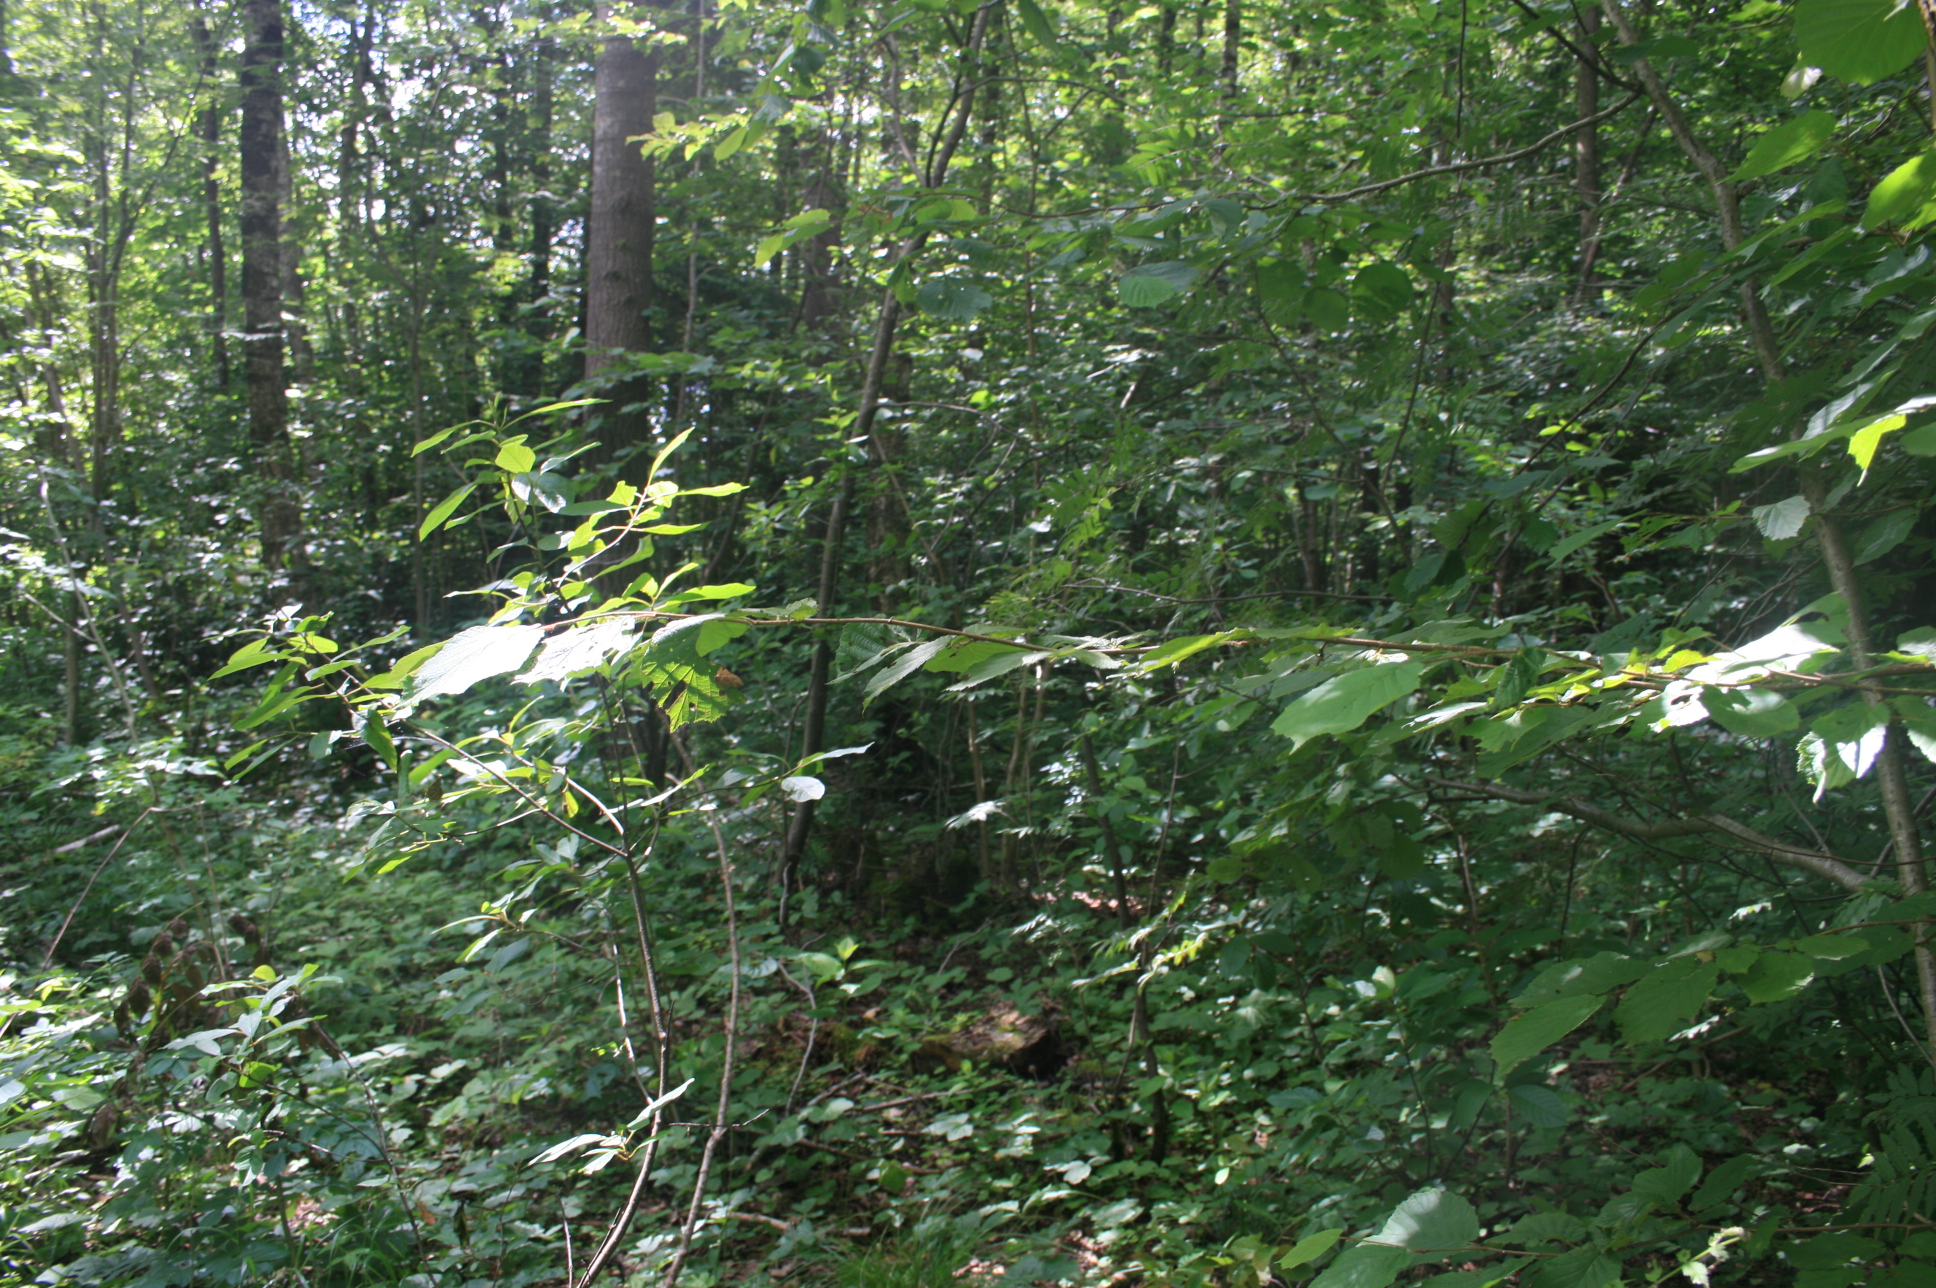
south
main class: Woodland
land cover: Broadleaved woodland
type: non-riverine alder, birch or aspen forest
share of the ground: > 75 %
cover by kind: broadleaved forest trees 90 %, shrubs 5 %, herbaceous plants 5 %
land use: Forestry
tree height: > 5 m
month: July
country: LT
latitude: 55.7857
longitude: 21.4135
